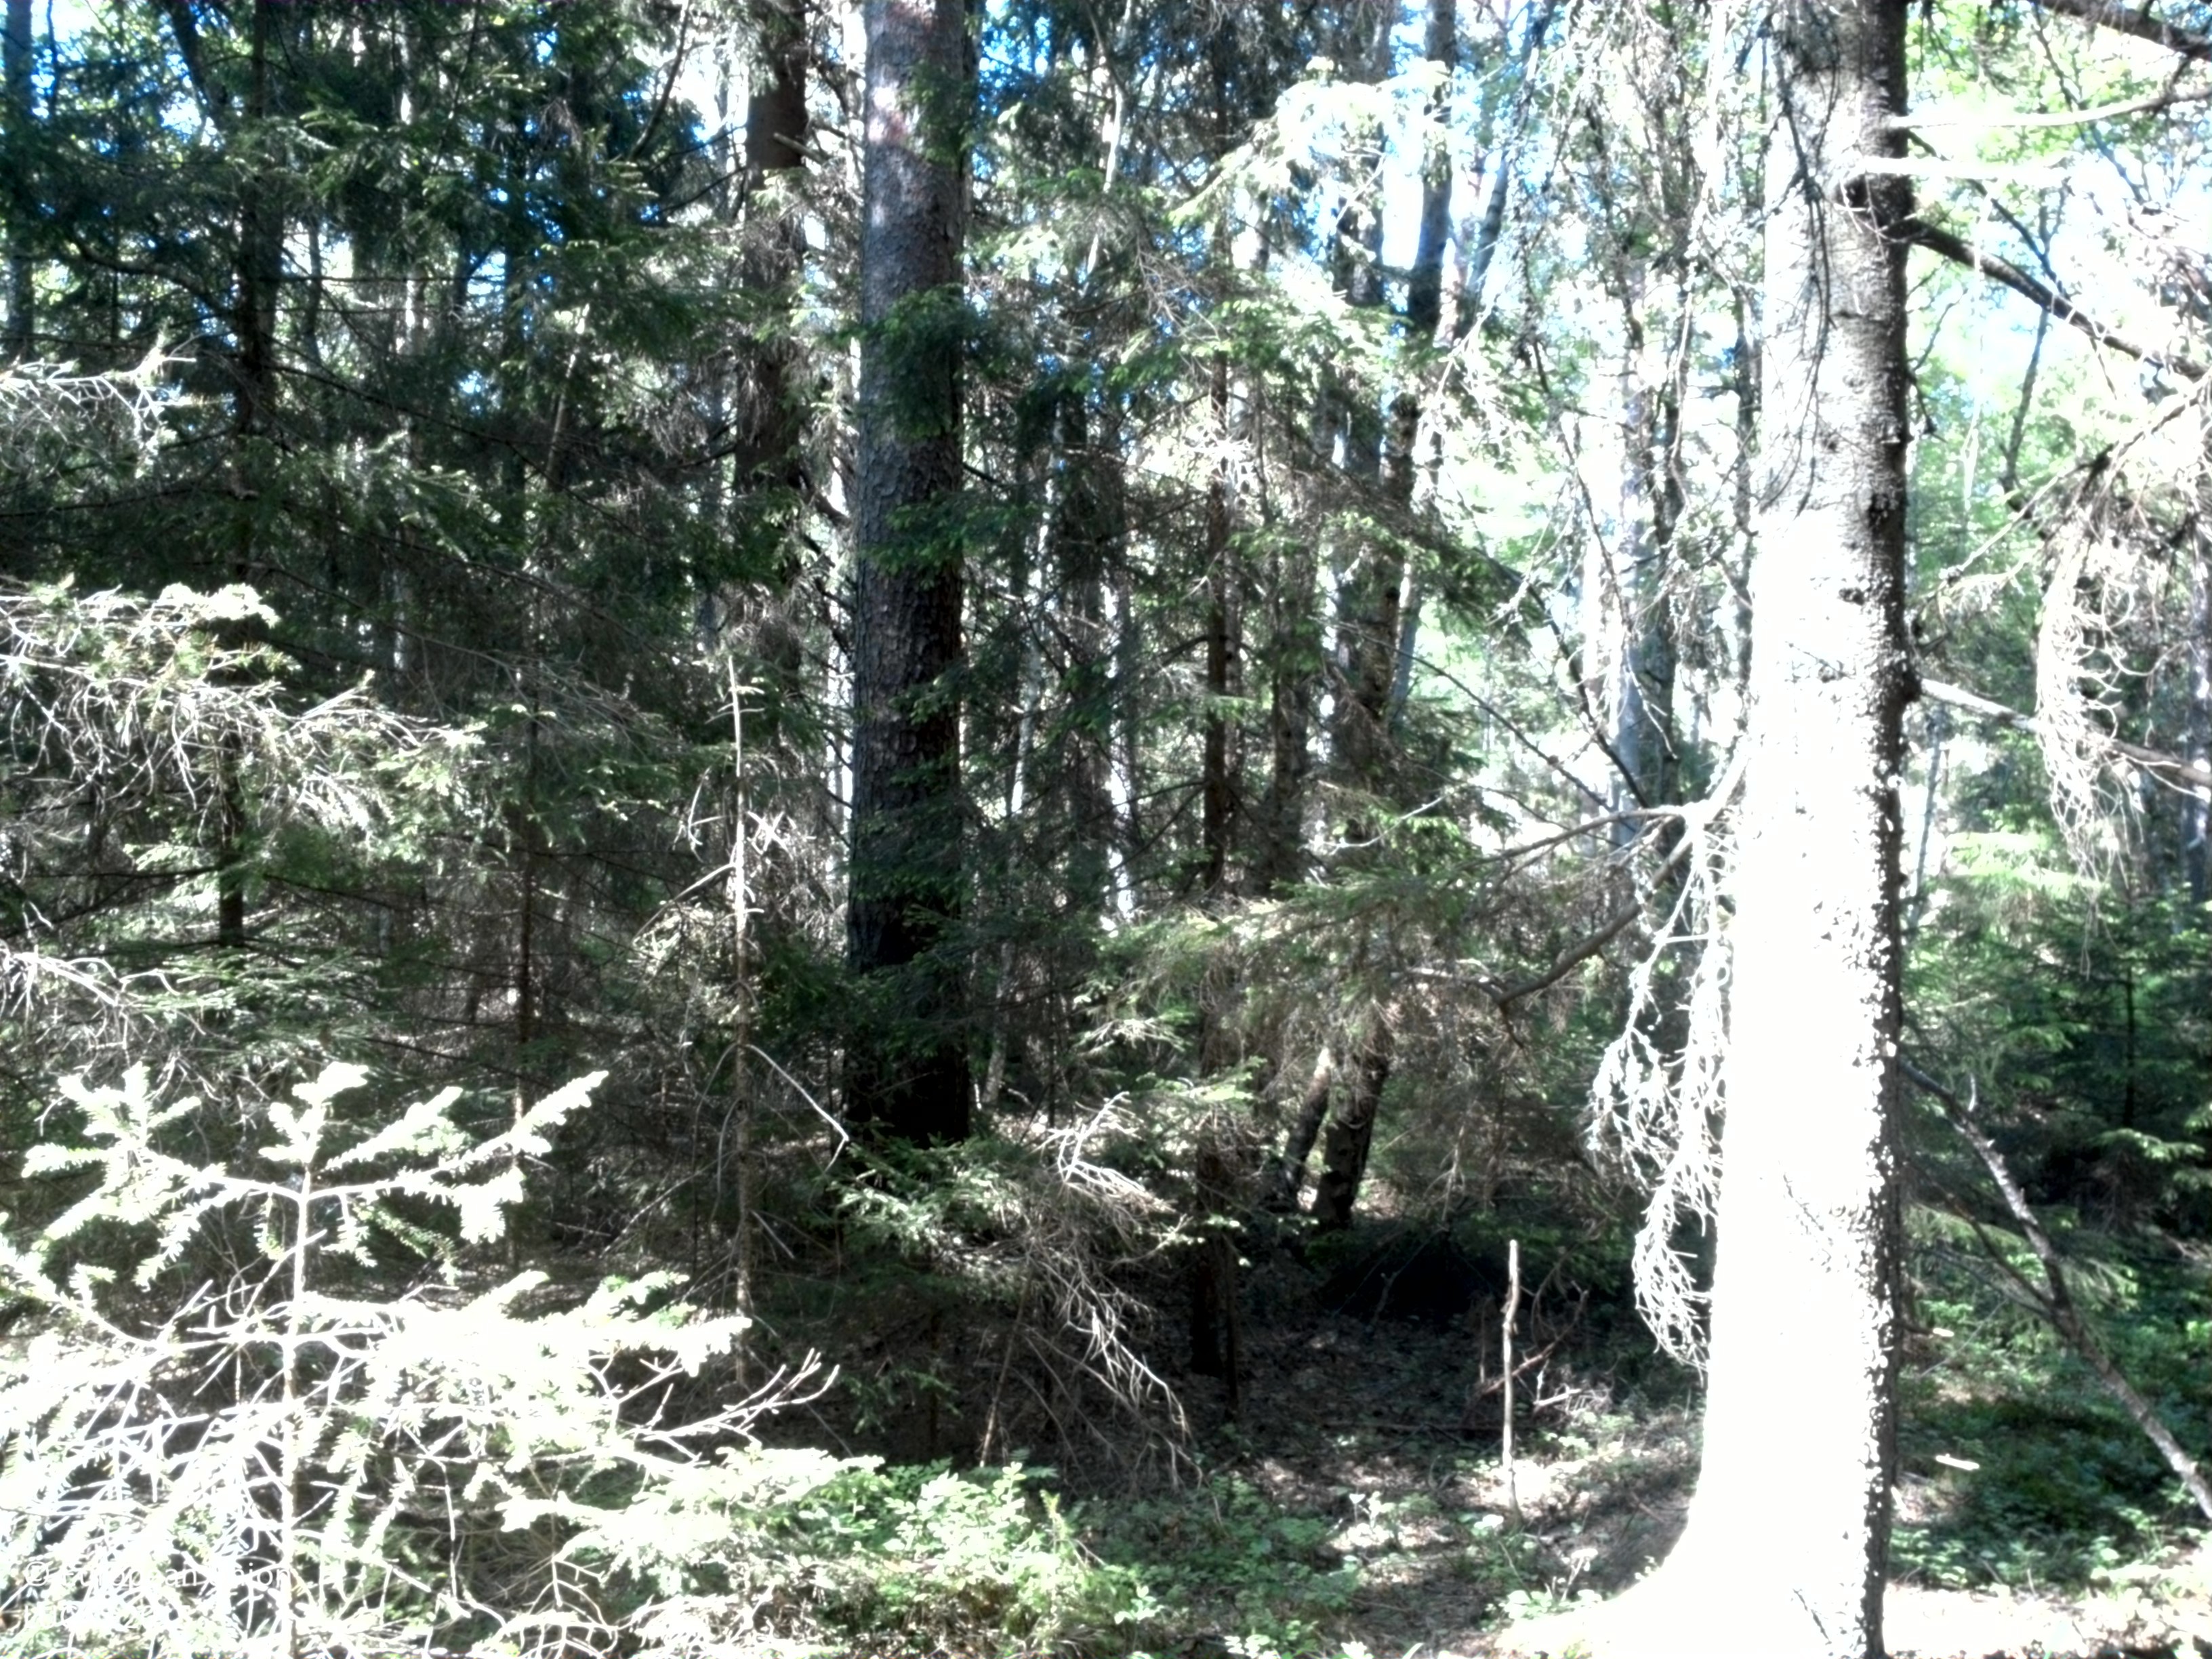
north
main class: Woodland
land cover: Spruce dominated mixed woodland
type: boreal forest
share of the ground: > 75 %
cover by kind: coniferous forest trees 60 %, broadleaved forest trees 20 %, shrubs 10 %, herbaceous plants 10 %
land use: Forestry
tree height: > 5 m
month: June
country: SE
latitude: 59.9736
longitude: 18.8682
